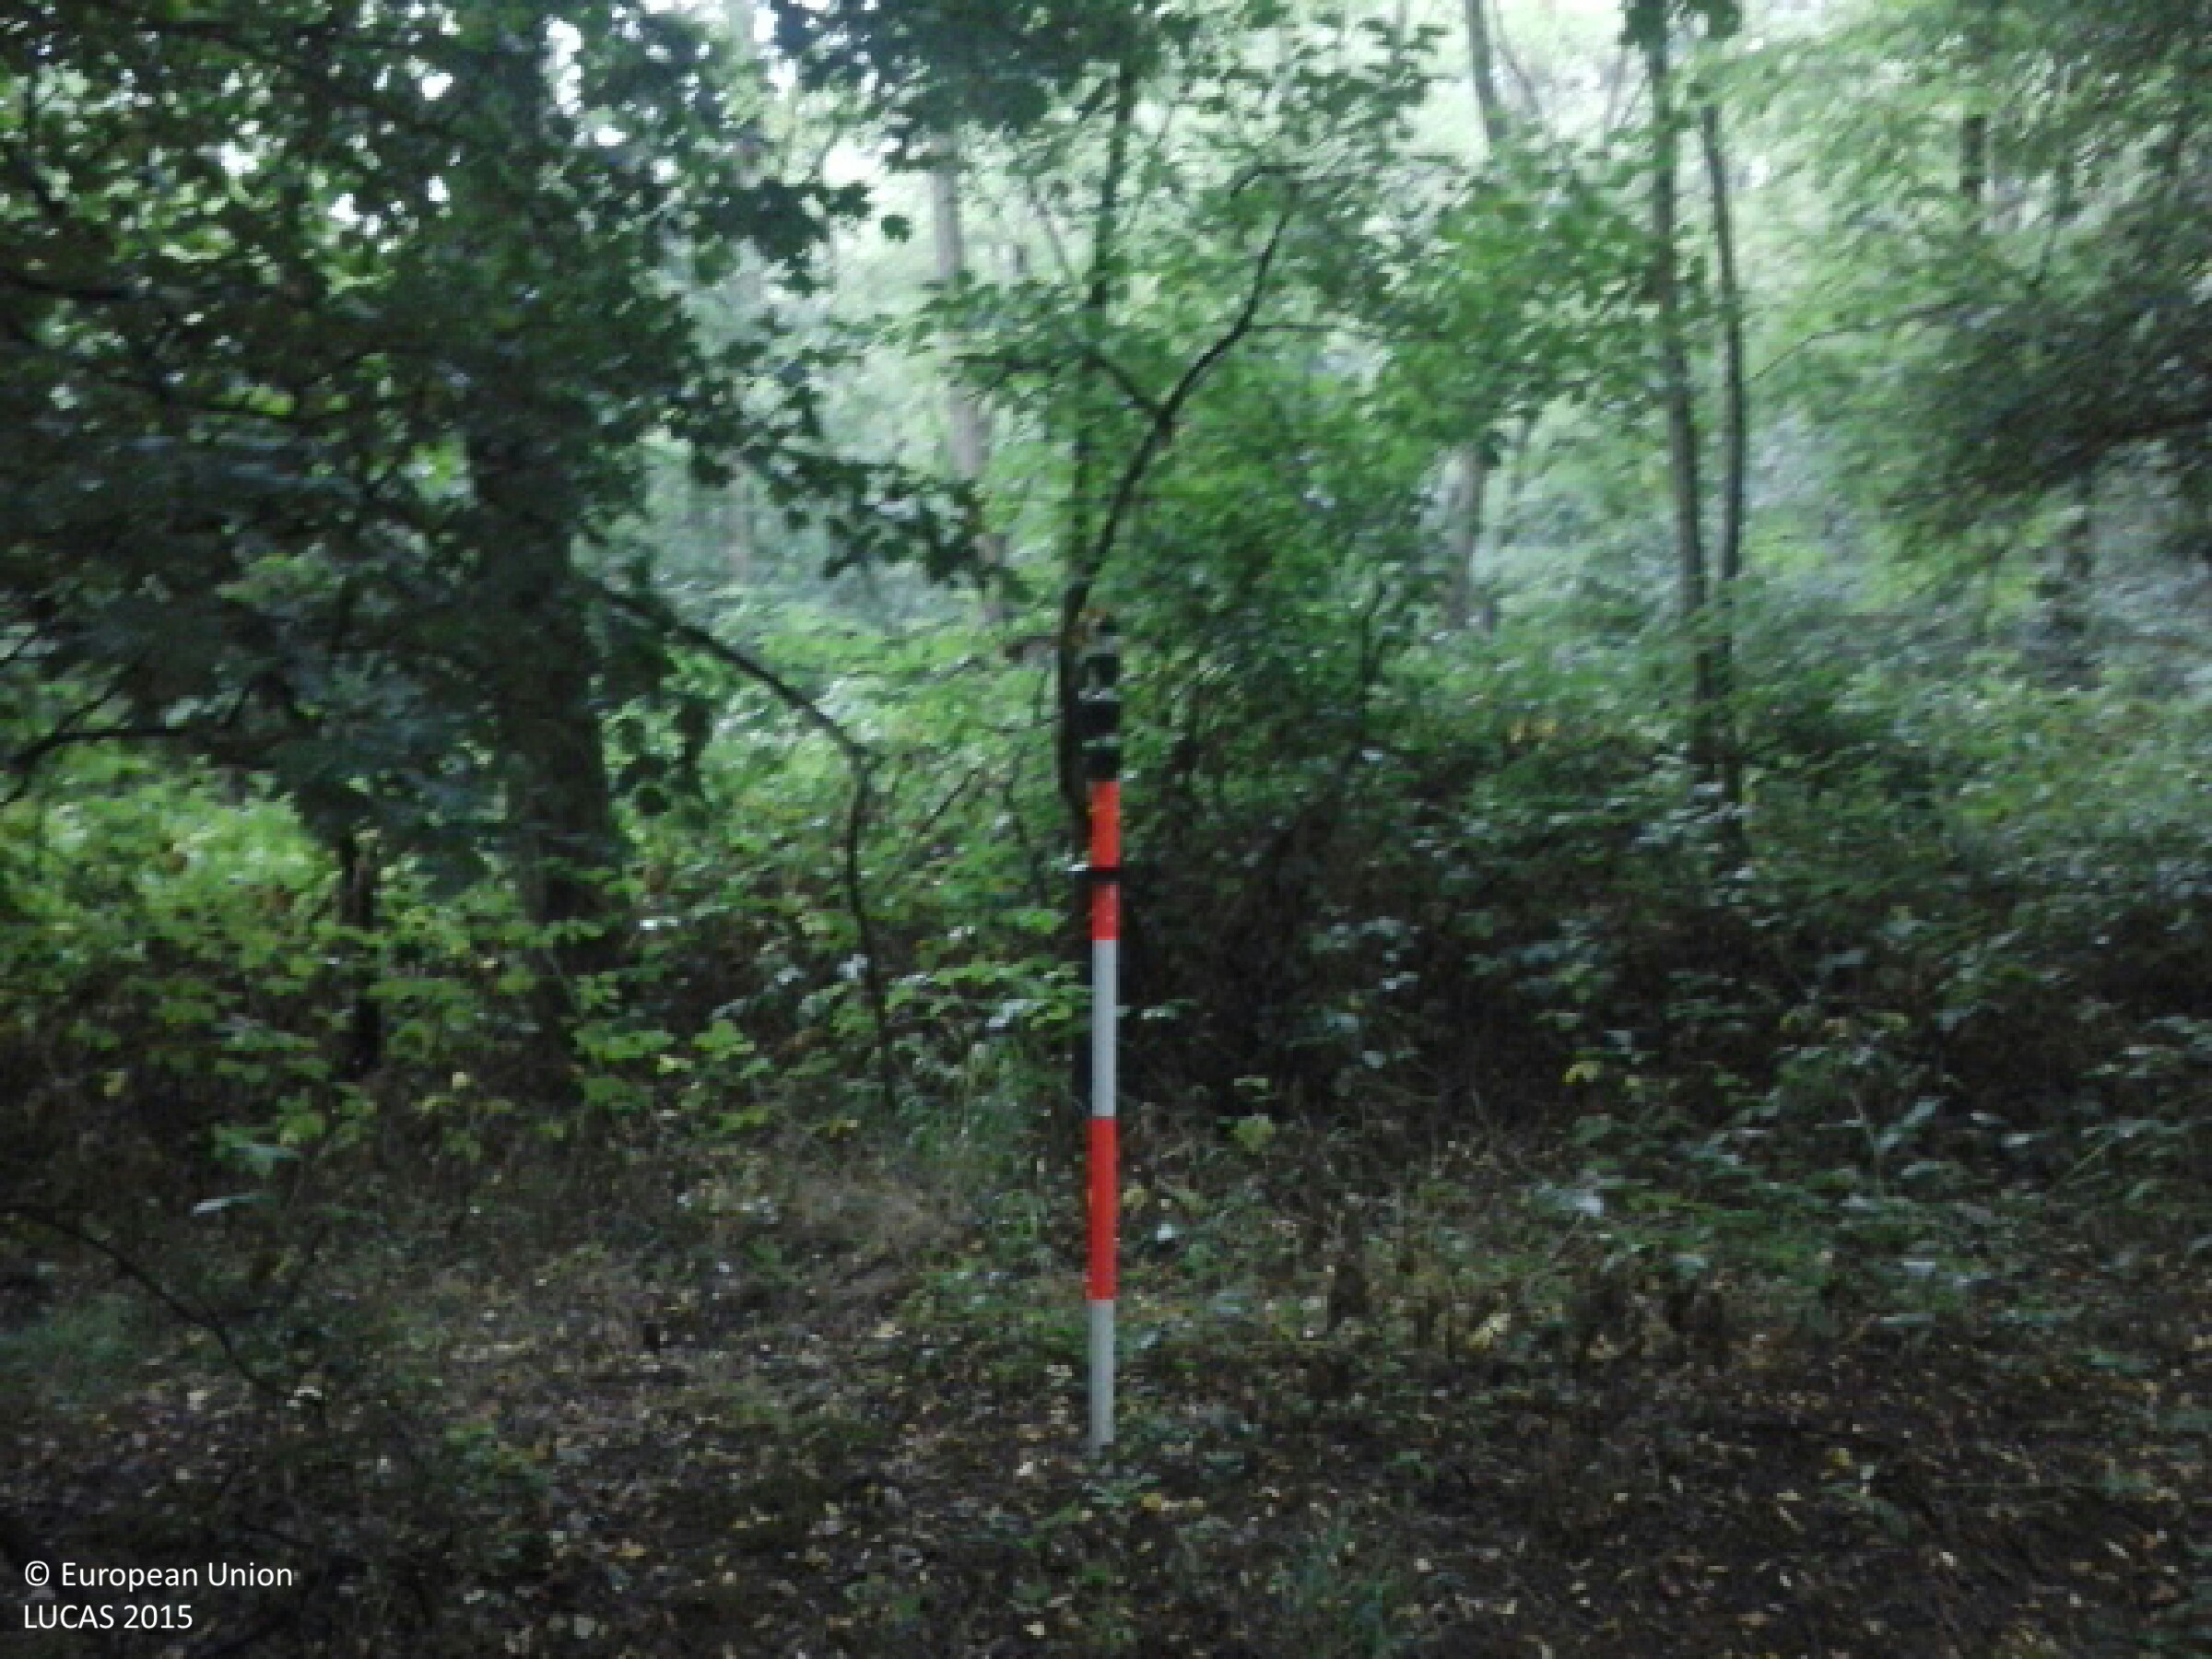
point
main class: Woodland
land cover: Broadleaved woodland
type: mesophytic deciduous forest
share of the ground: > 75 %
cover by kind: broadleaved forest trees 95 %, shrubs 5 %
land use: Forestry
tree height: > 5 m
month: July
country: HU
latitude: 48.5031
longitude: 21.5658
